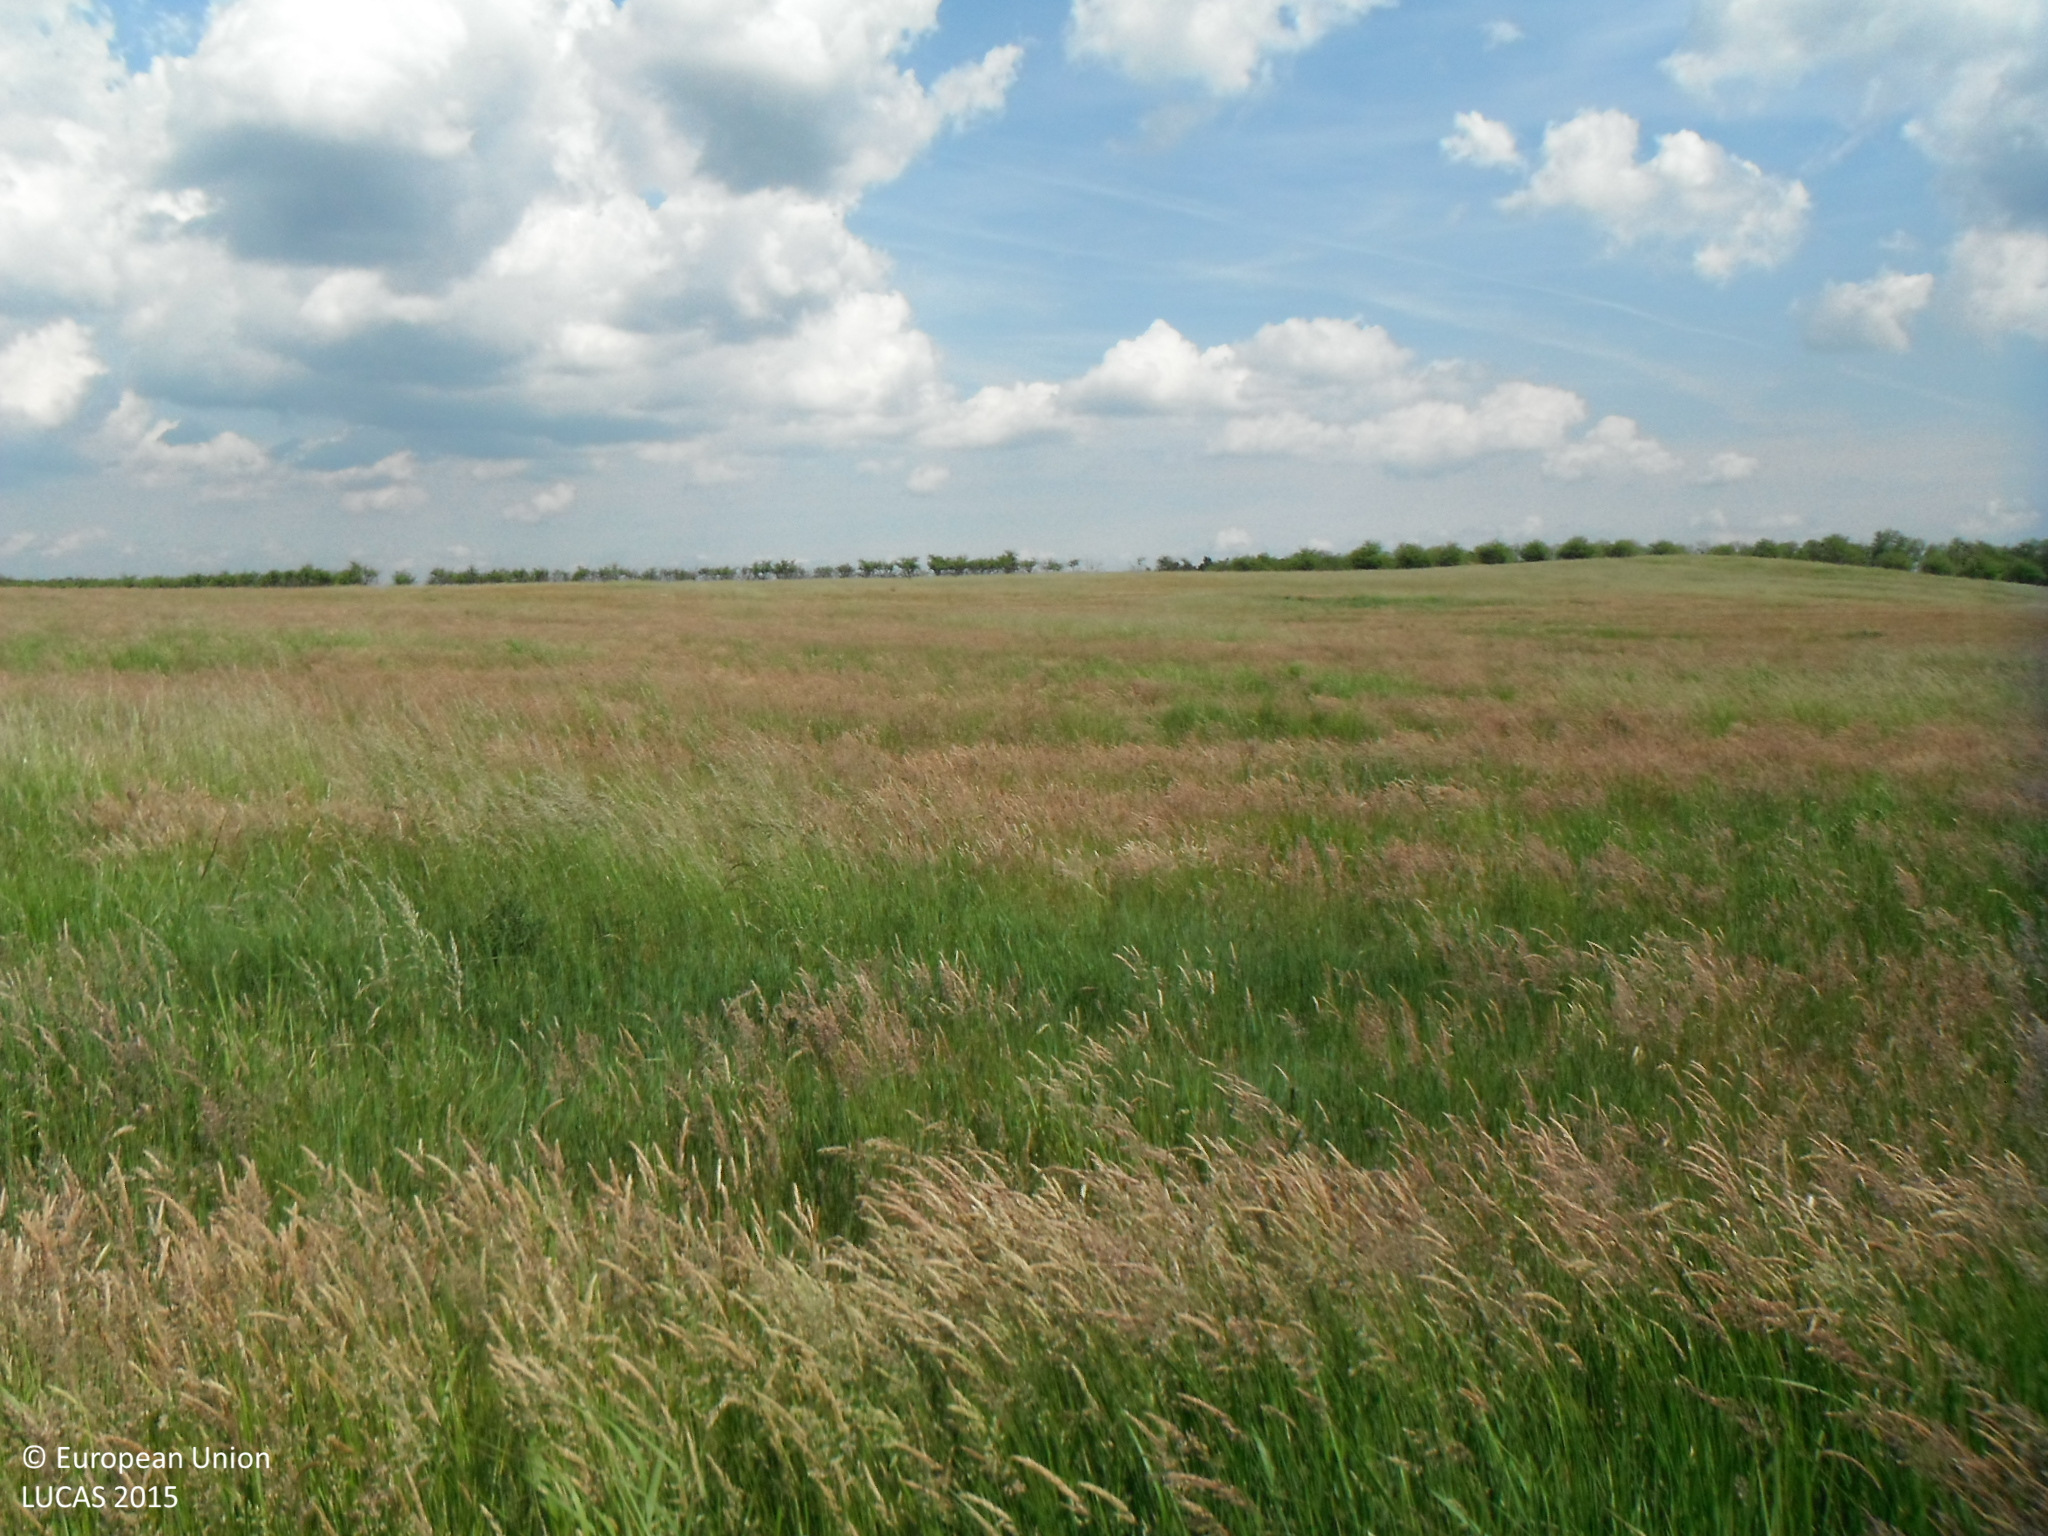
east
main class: Grassland
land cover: Grassland without tree/shrub cover
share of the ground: > 75 %
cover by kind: herbaceous plants 100 %
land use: Agriculture (excluding fallow land and kitchen gardens)
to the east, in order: Grassland without tree/shrub cover; Apple fruit; Grassland without tree/shrub cover
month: June
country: SK
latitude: 48.5940
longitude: 17.0455
